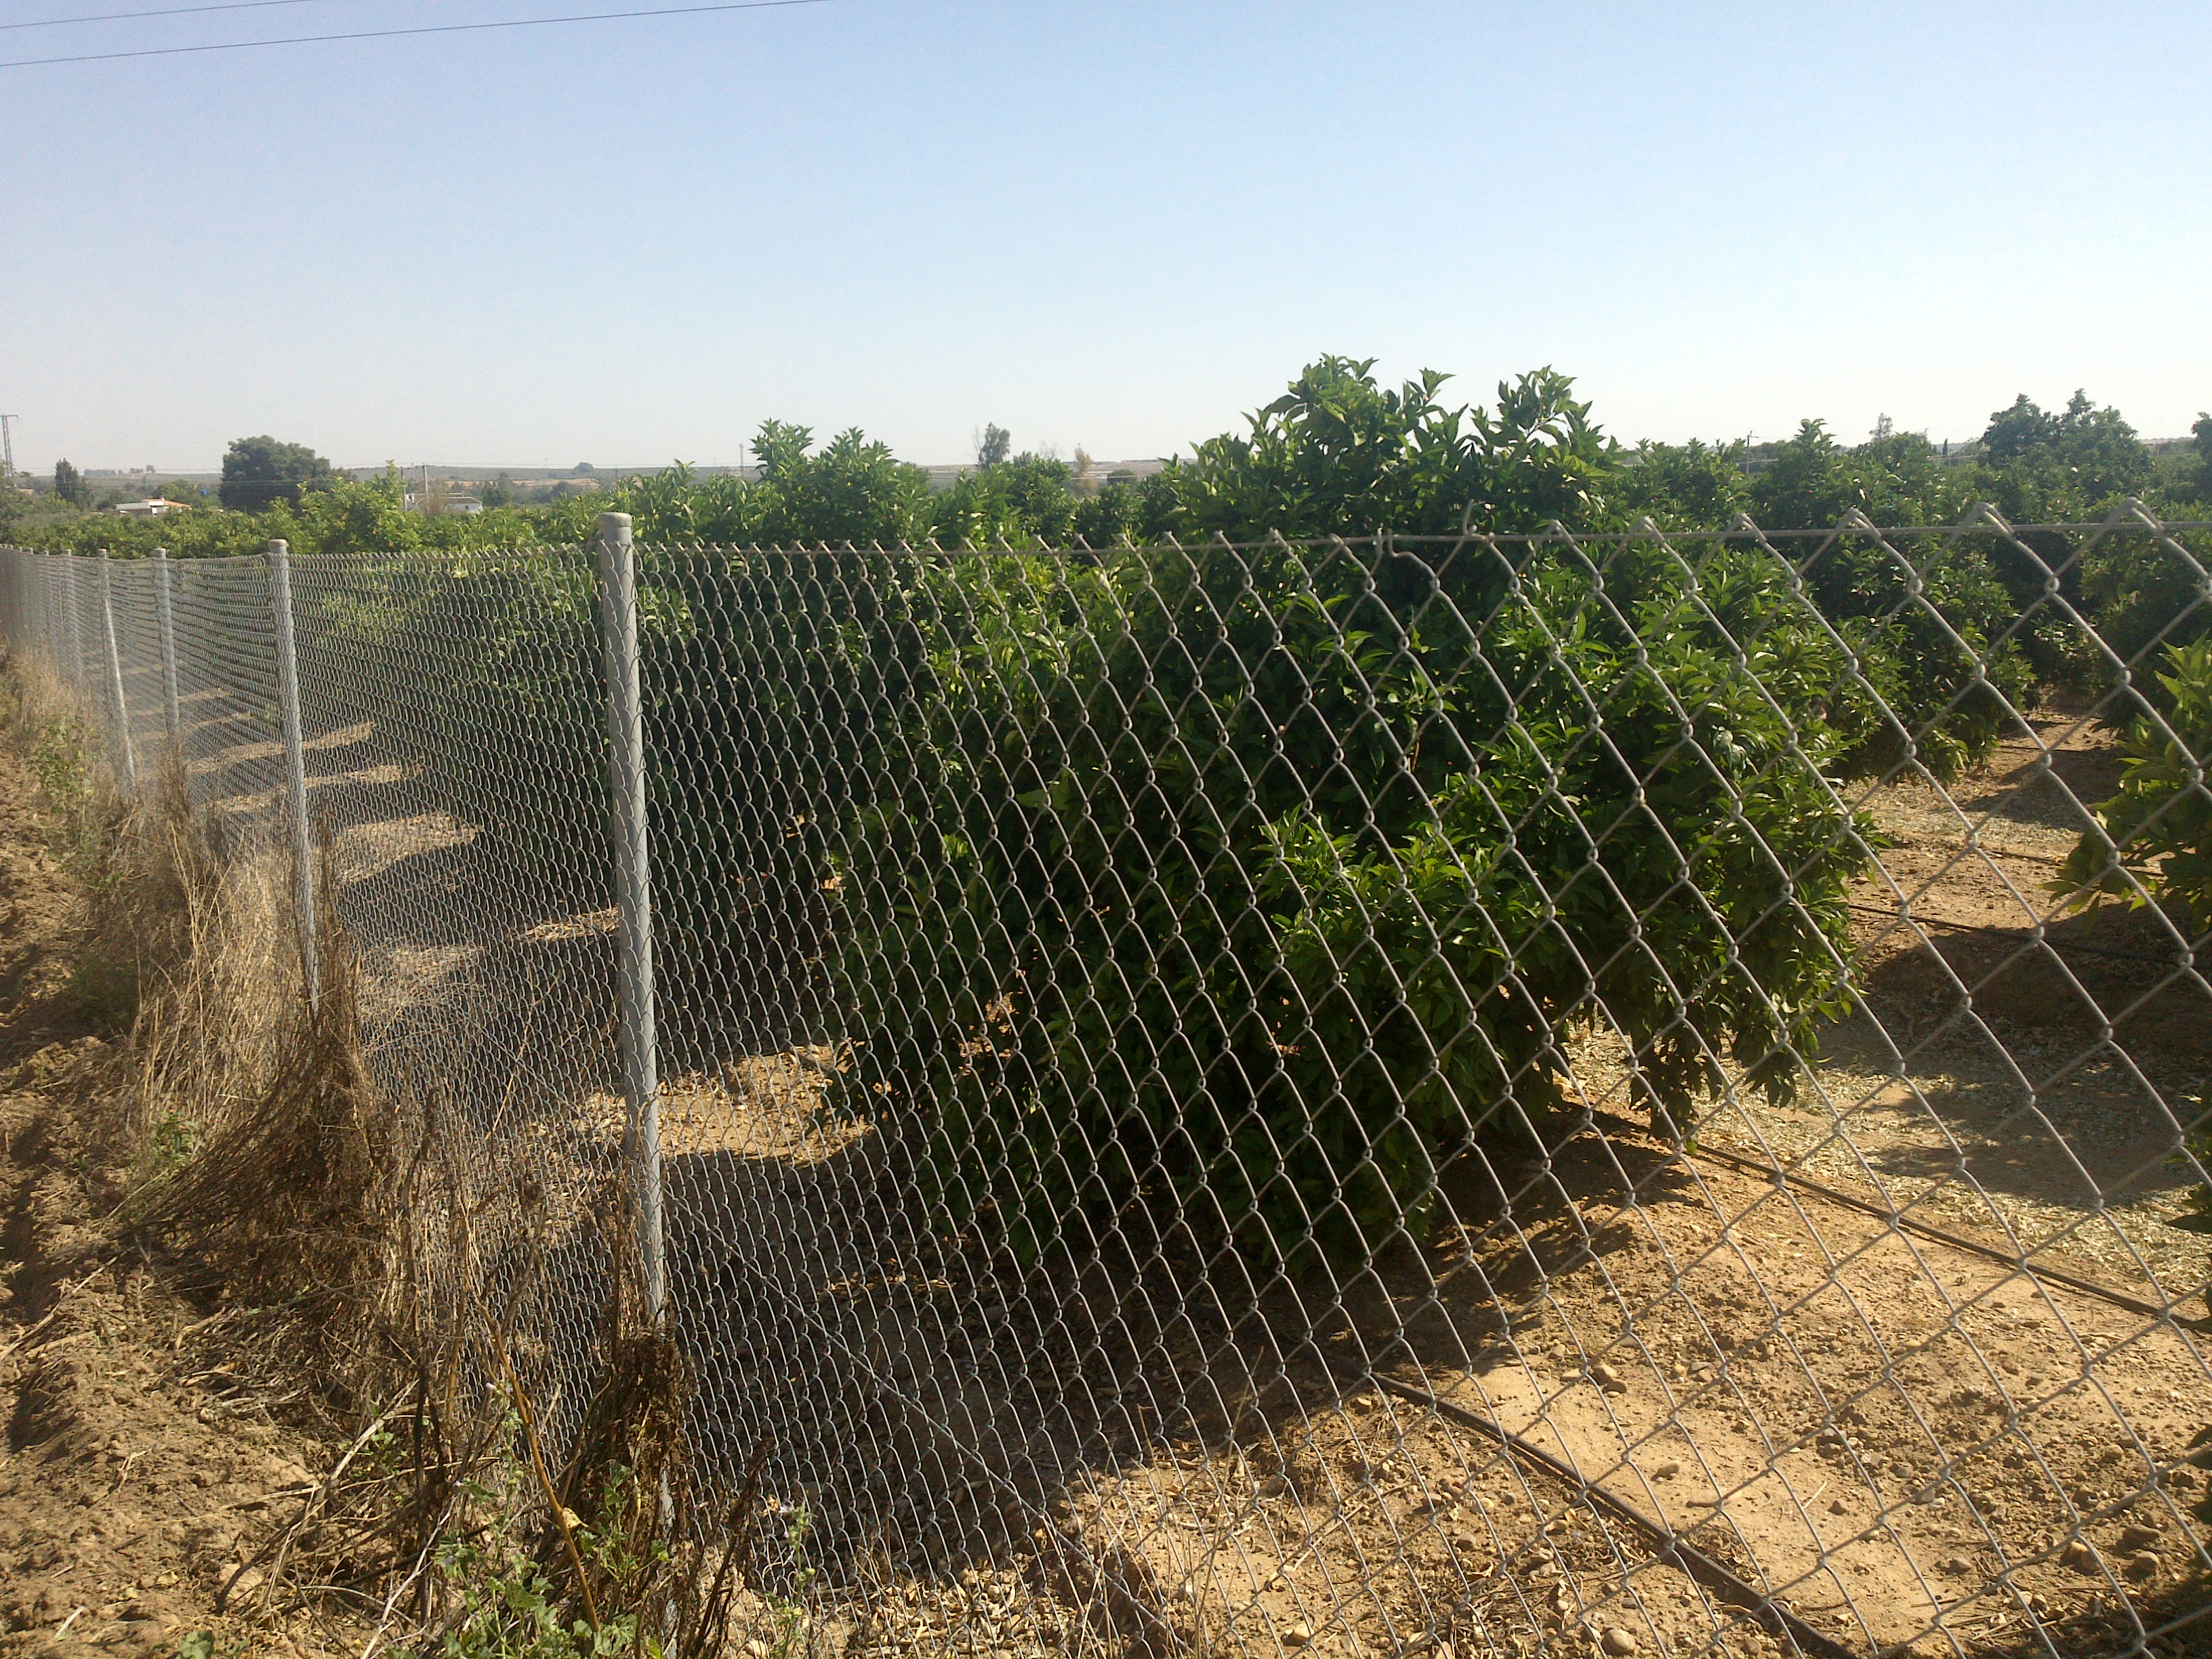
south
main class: Cropland
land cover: Oranges
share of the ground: 50 - 75 %
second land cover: Other bare soil
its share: > 75 %
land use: Agriculture (excluding fallow land and kitchen gardens)
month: May
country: ES
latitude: 37.8201
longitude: -5.0005
